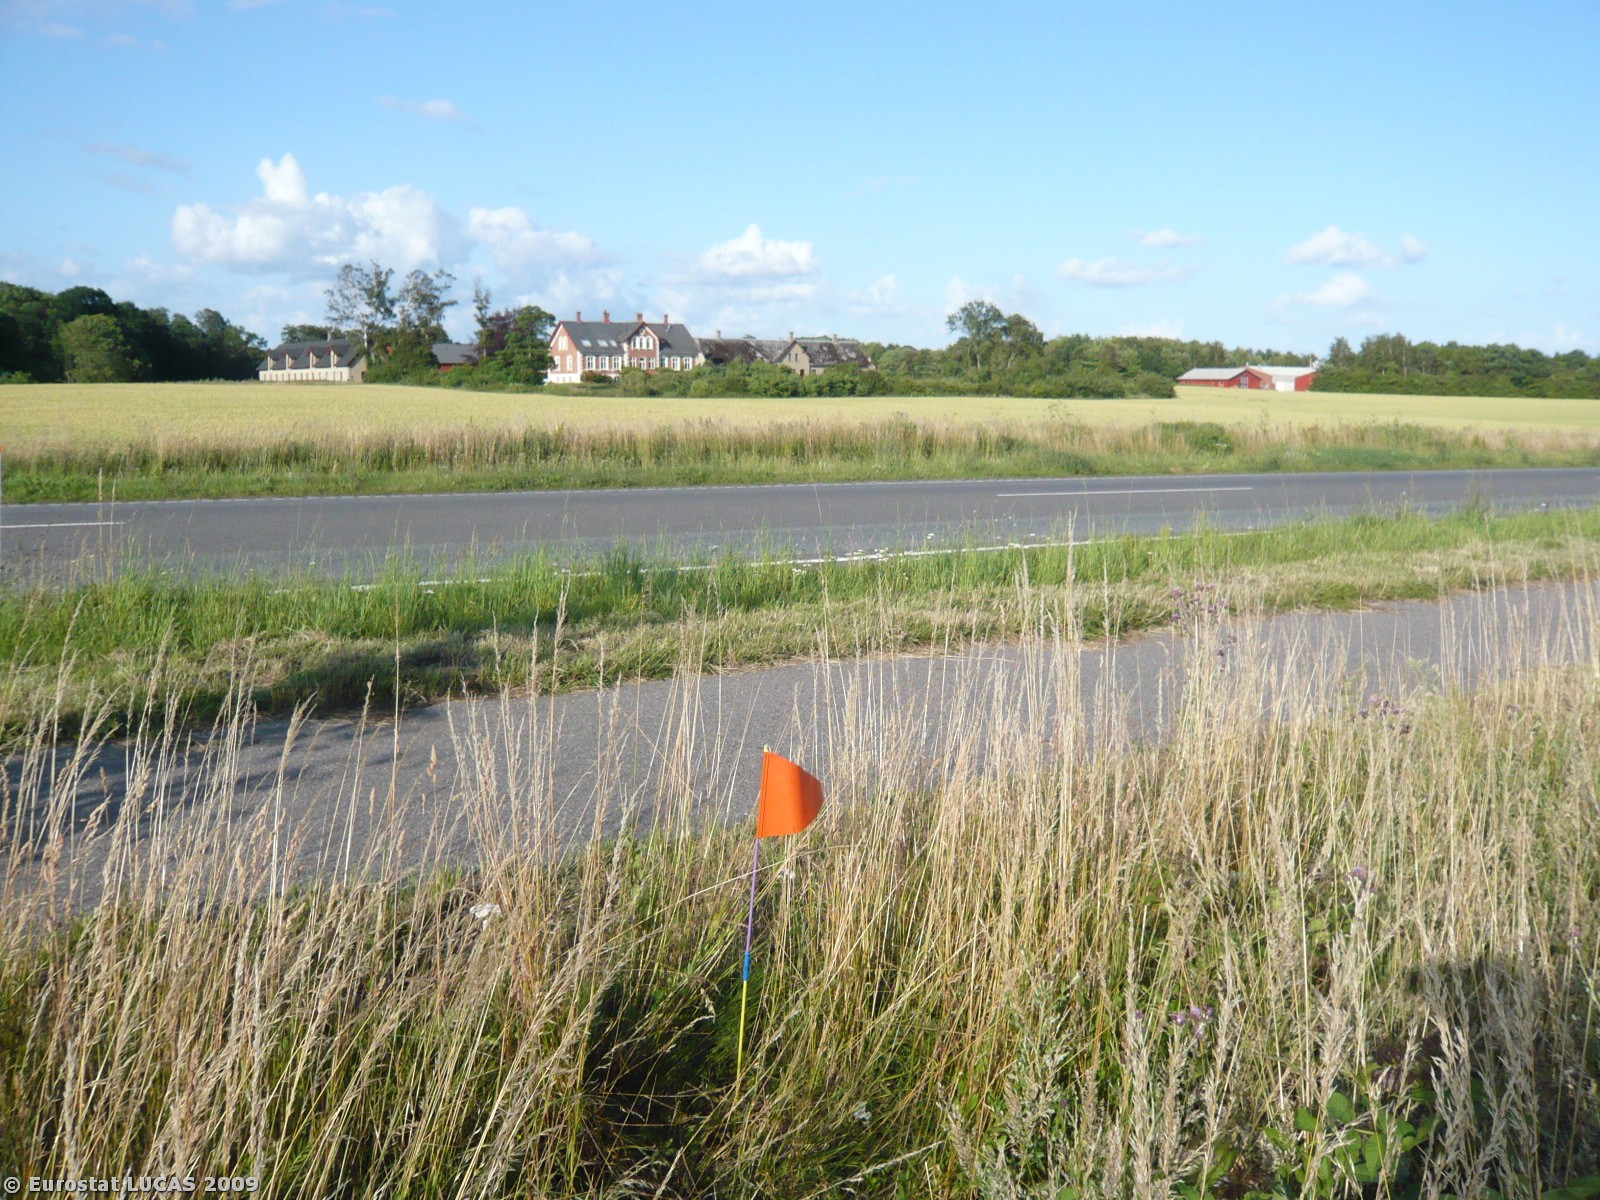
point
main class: Grassland
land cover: Grassland without tree/shrub cover
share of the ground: > 75 %
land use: Unused
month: July
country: DK
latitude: 55.3226
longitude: 10.7715
